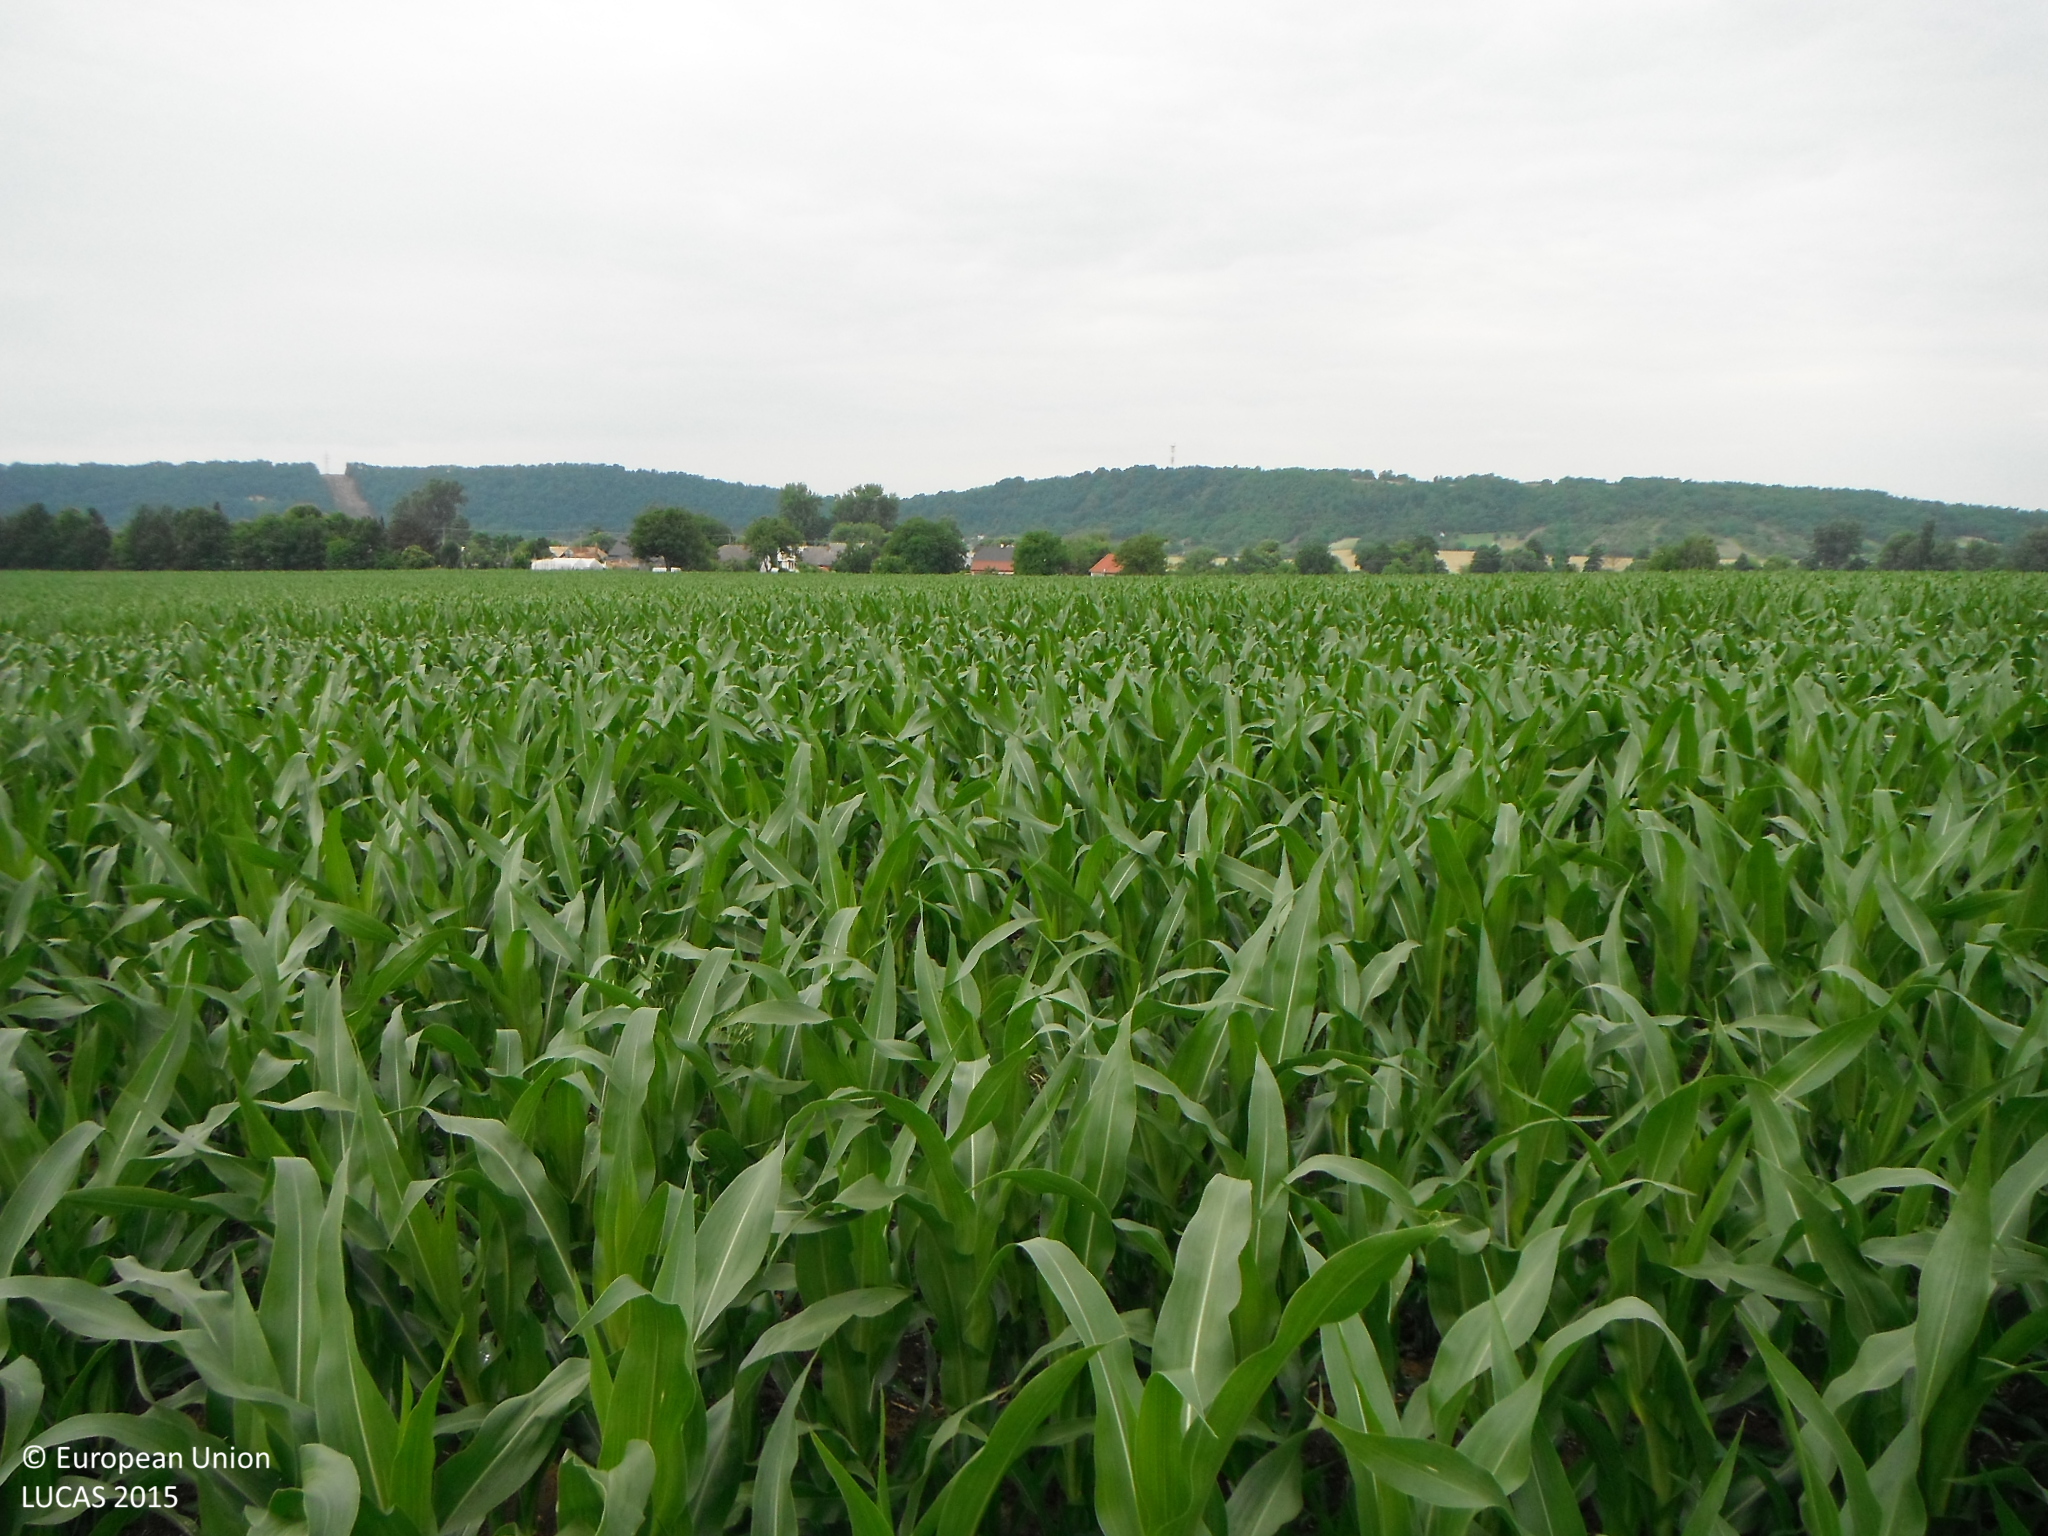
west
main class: Cropland
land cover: Maize
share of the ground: > 75 %
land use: Agriculture (excluding fallow land and kitchen gardens)
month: June
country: SK
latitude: 48.1123
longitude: 18.9512
